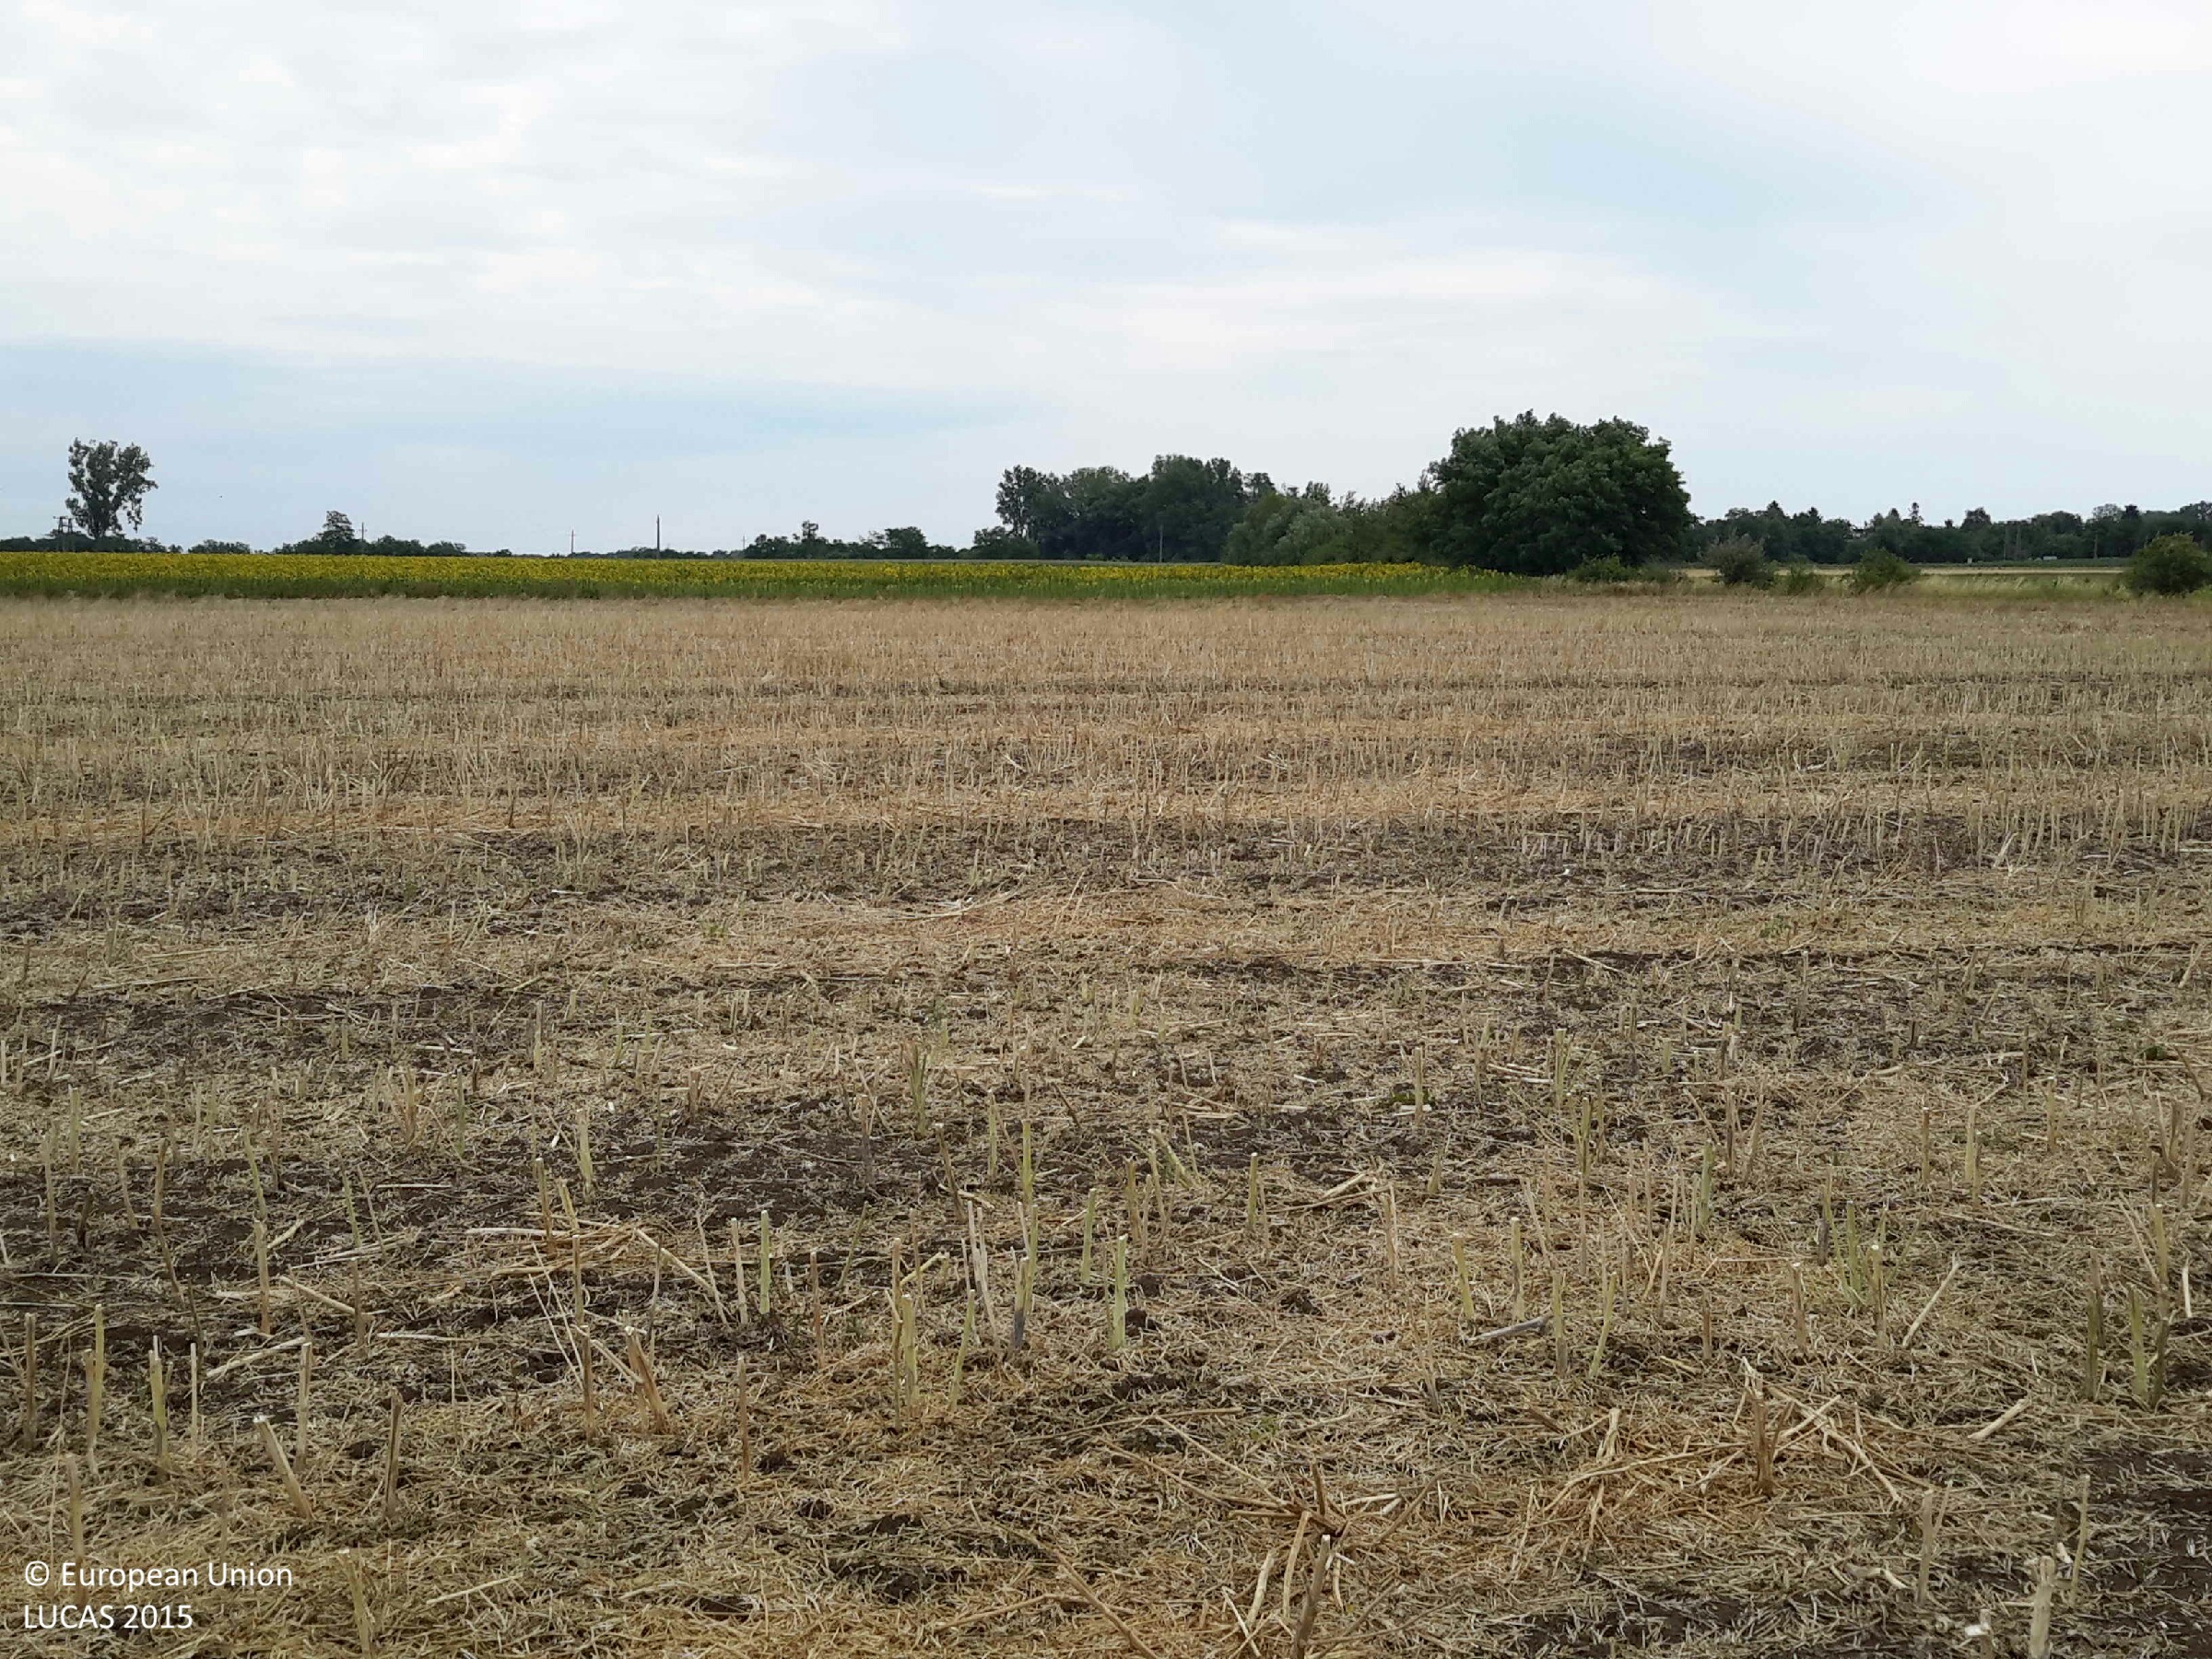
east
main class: Cropland
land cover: Rape and turnip rape
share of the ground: < 10 %
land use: Agriculture (excluding fallow land and kitchen gardens)
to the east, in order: Rape and turnip rape; Sunflower
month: July
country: HU
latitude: 47.4437
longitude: 17.2339
